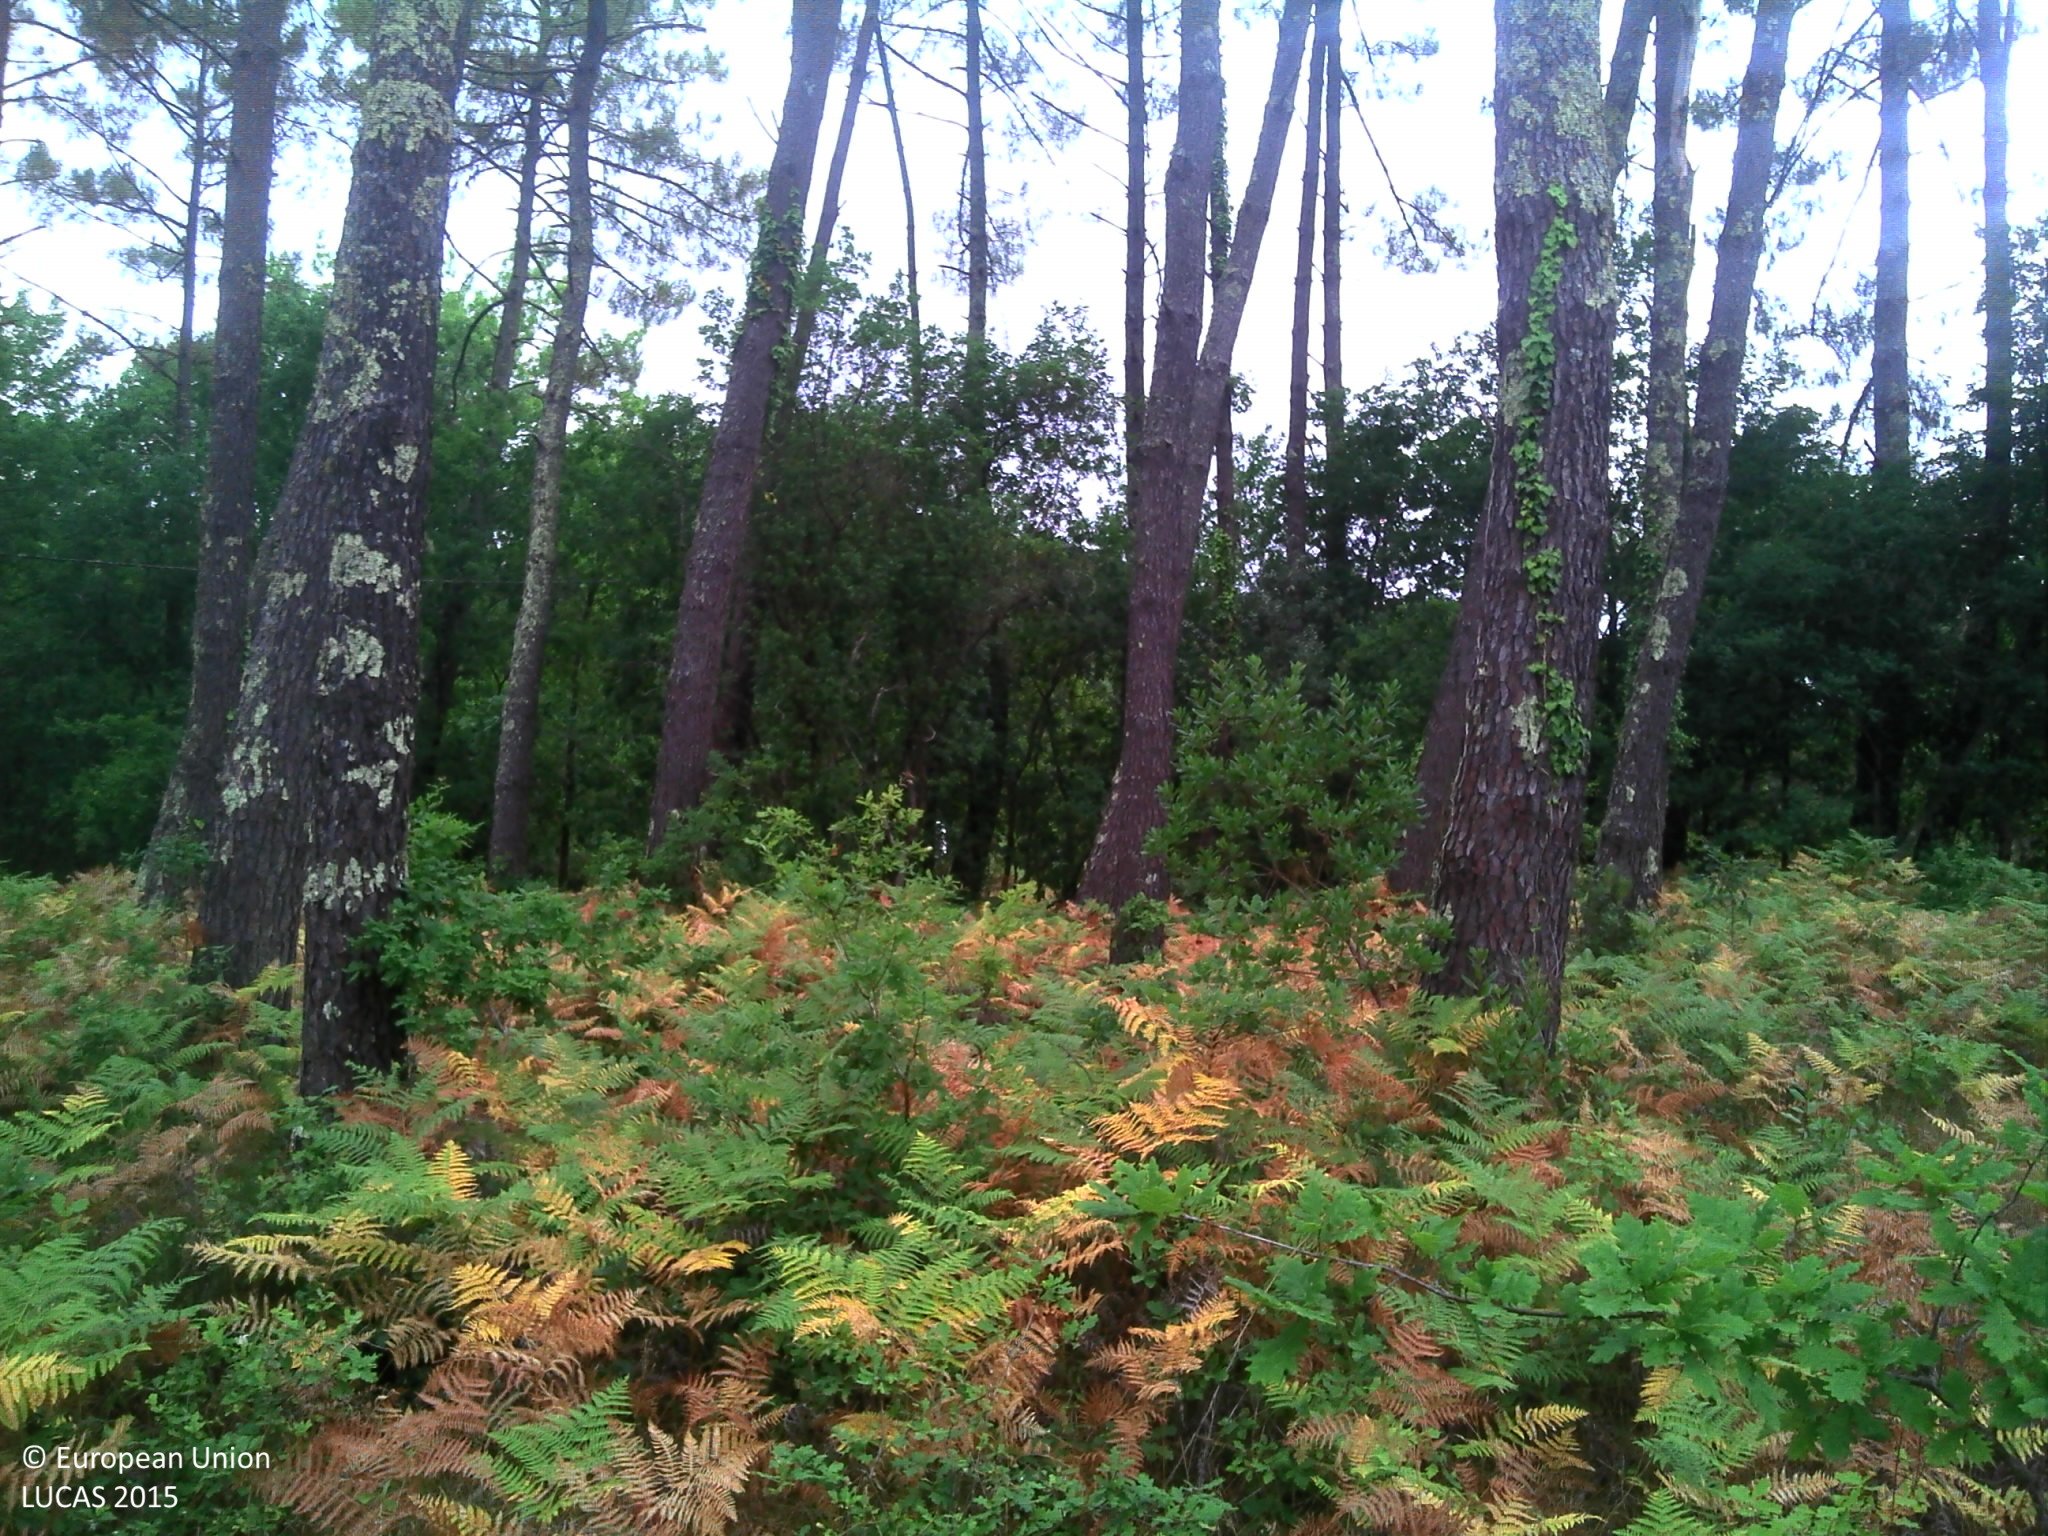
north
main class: Woodland
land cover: Pine dominated coniferous woodland
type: exotic forest
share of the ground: > 75 %
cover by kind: coniferous forest trees 80 %, herbaceous plants 20 %
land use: Forestry
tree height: > 5 m
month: July
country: FR
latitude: 44.3536
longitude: -1.0984
